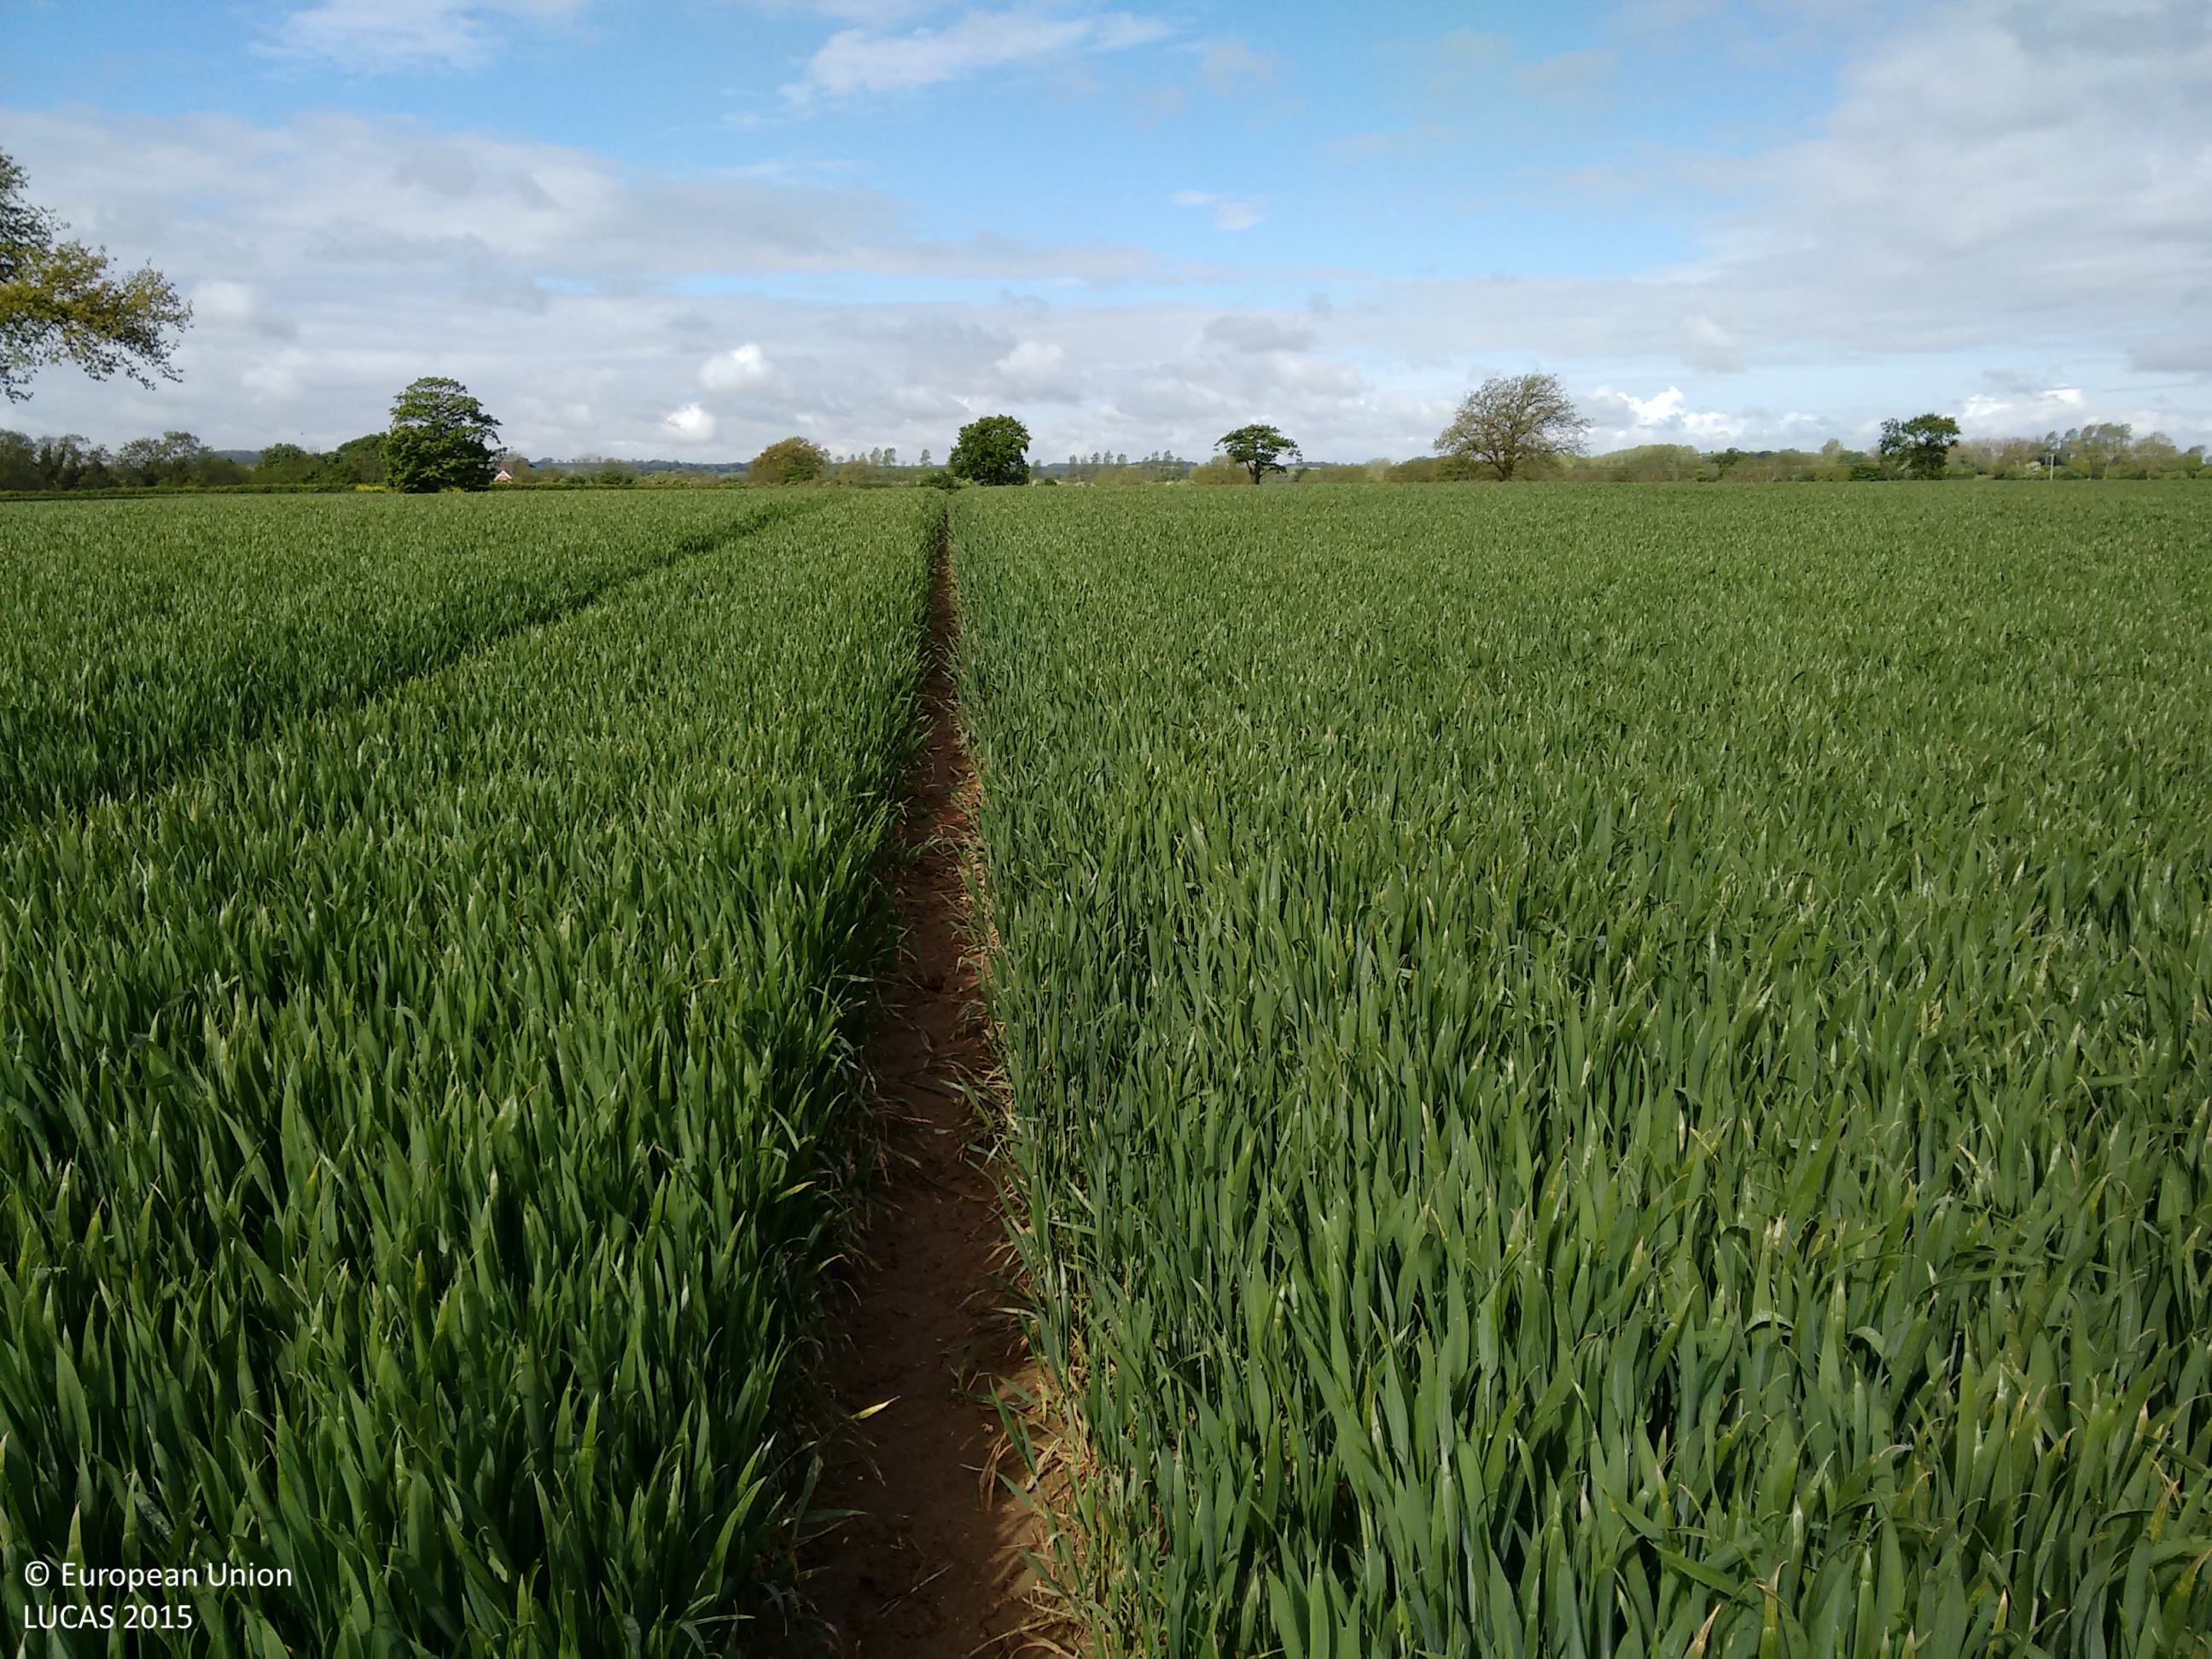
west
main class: Cropland
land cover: Common wheat
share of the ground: > 75 %
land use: Agriculture (excluding fallow land and kitchen gardens)
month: May
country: GB
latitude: 53.4721
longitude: -0.0508
